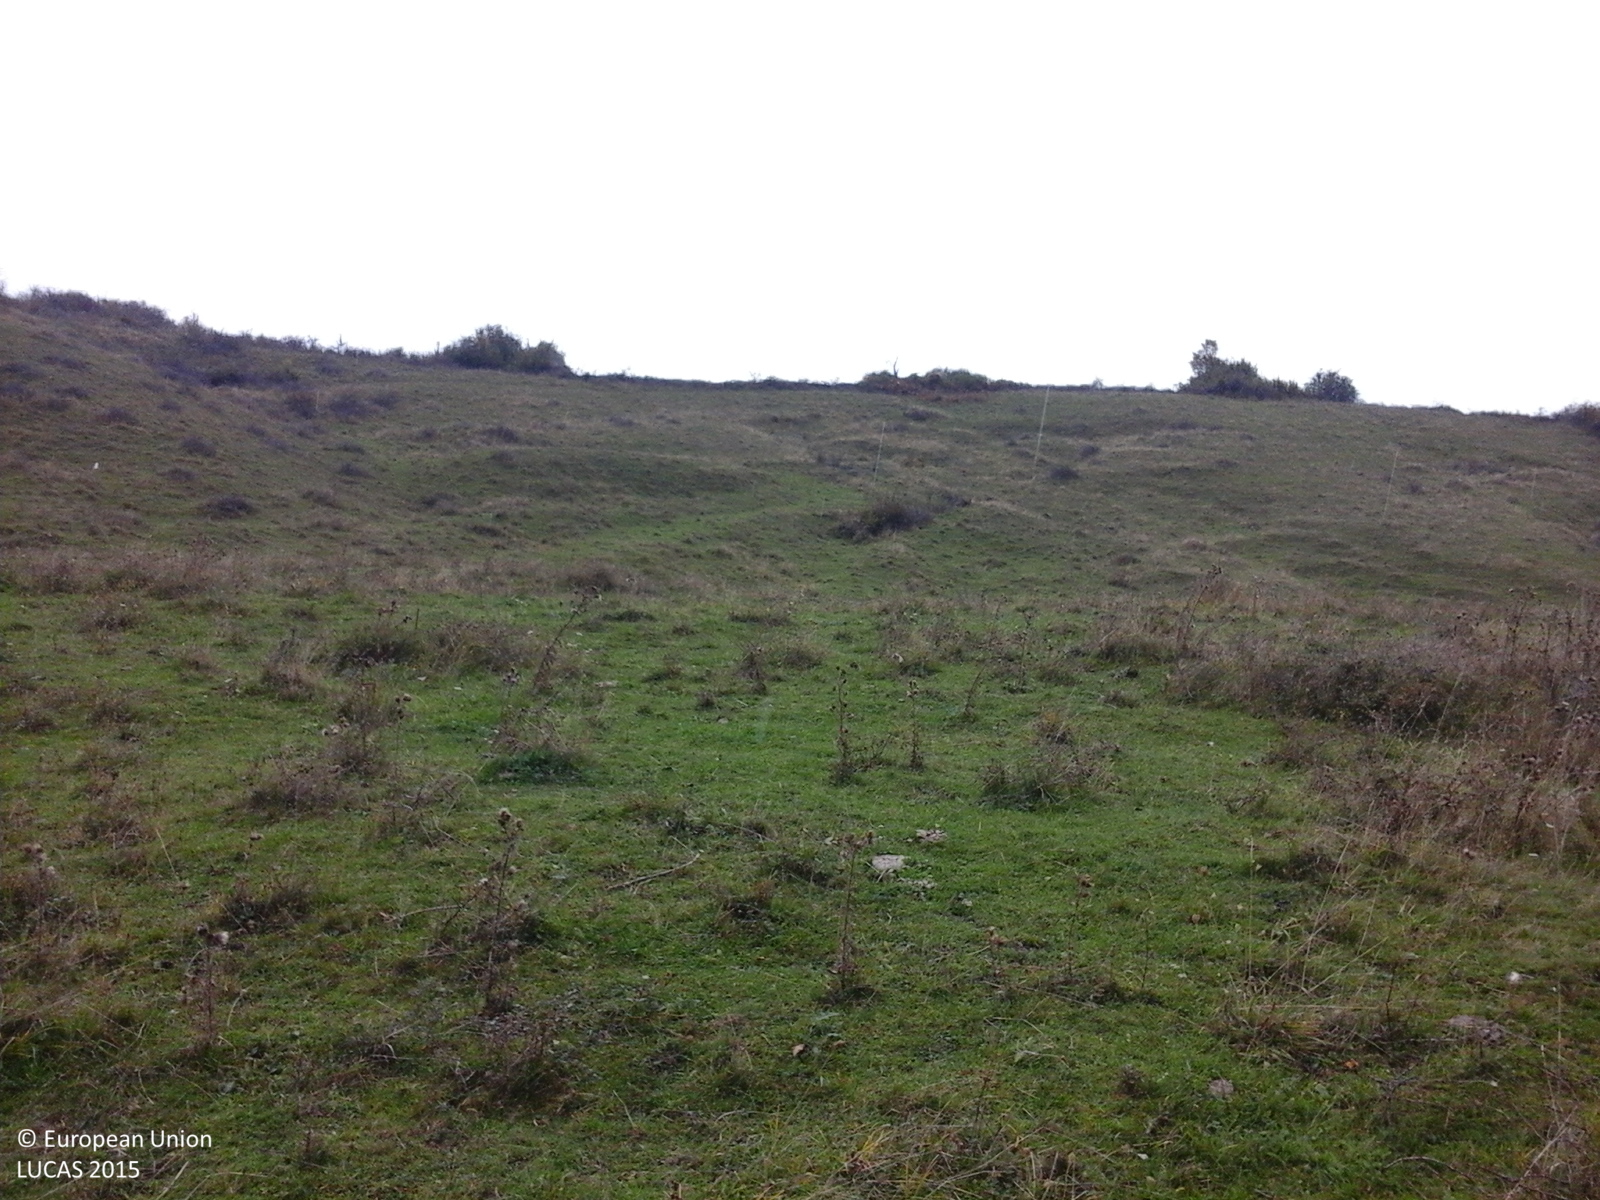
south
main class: Grassland
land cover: Grassland without tree/shrub cover
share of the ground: > 75 %
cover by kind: herbaceous plants 100 %
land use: Agriculture (excluding fallow land and kitchen gardens)
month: October
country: RO
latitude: 46.6157
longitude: 24.9172
